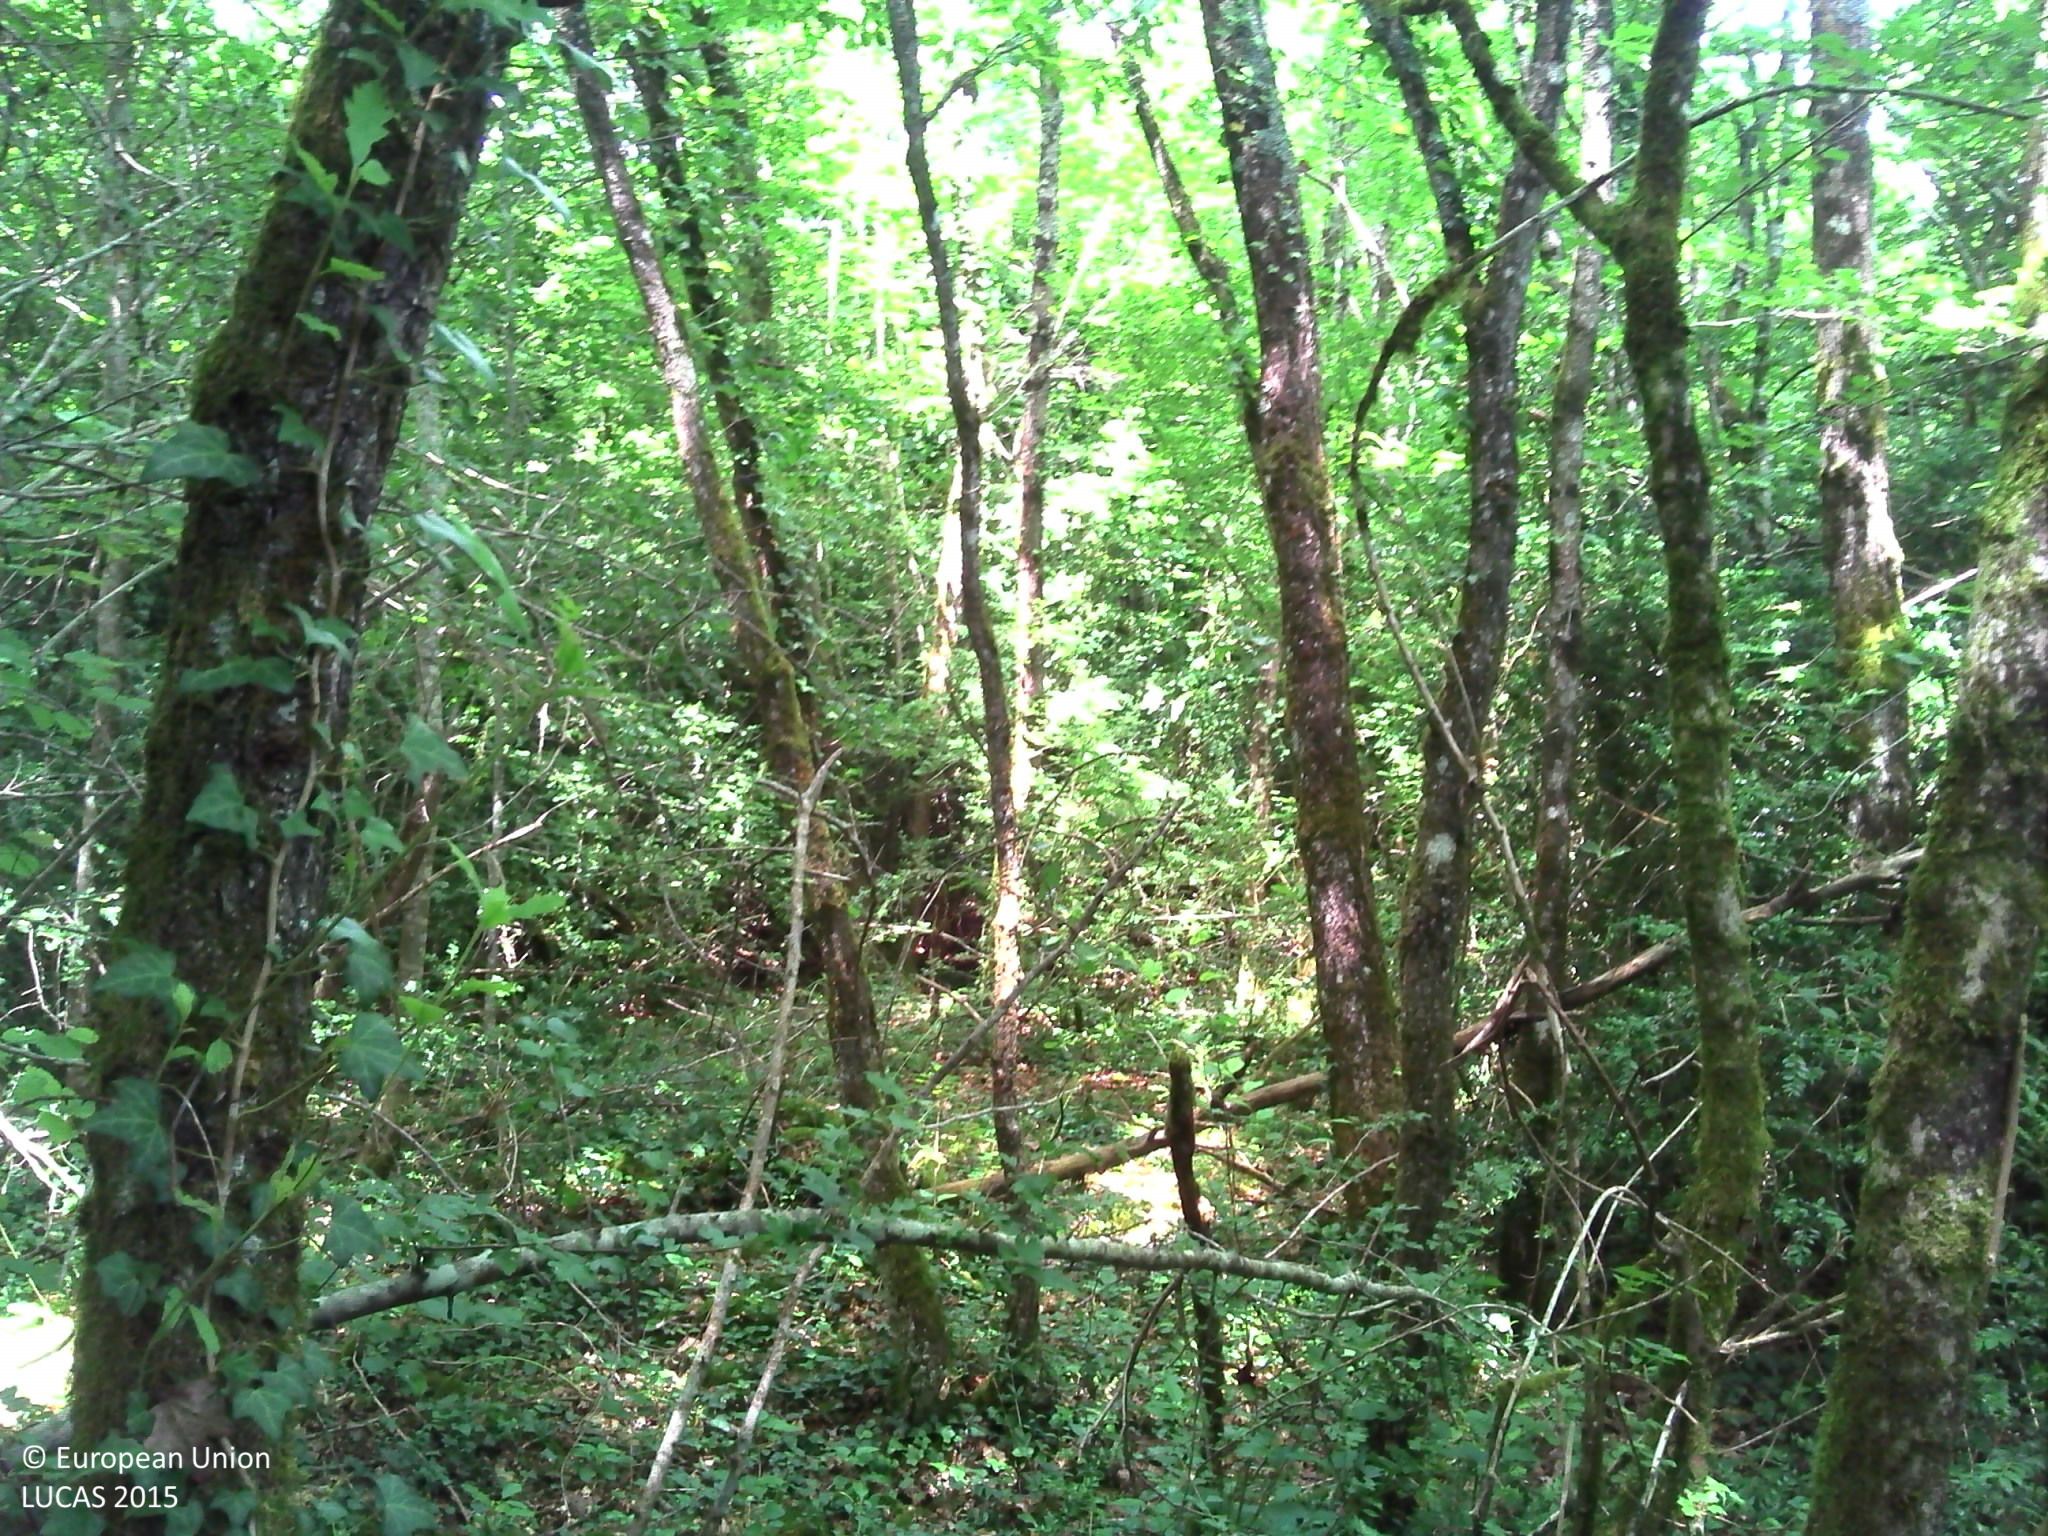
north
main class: Woodland
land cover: Broadleaved woodland
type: thermophilous deciduous forest
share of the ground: > 75 %
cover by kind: broadleaved forest trees 85 %, herbaceous plants 10 %, shrubs 5 %
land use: Forestry
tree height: > 5 m
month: June
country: FR
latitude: 45.7156
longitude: 0.3627
